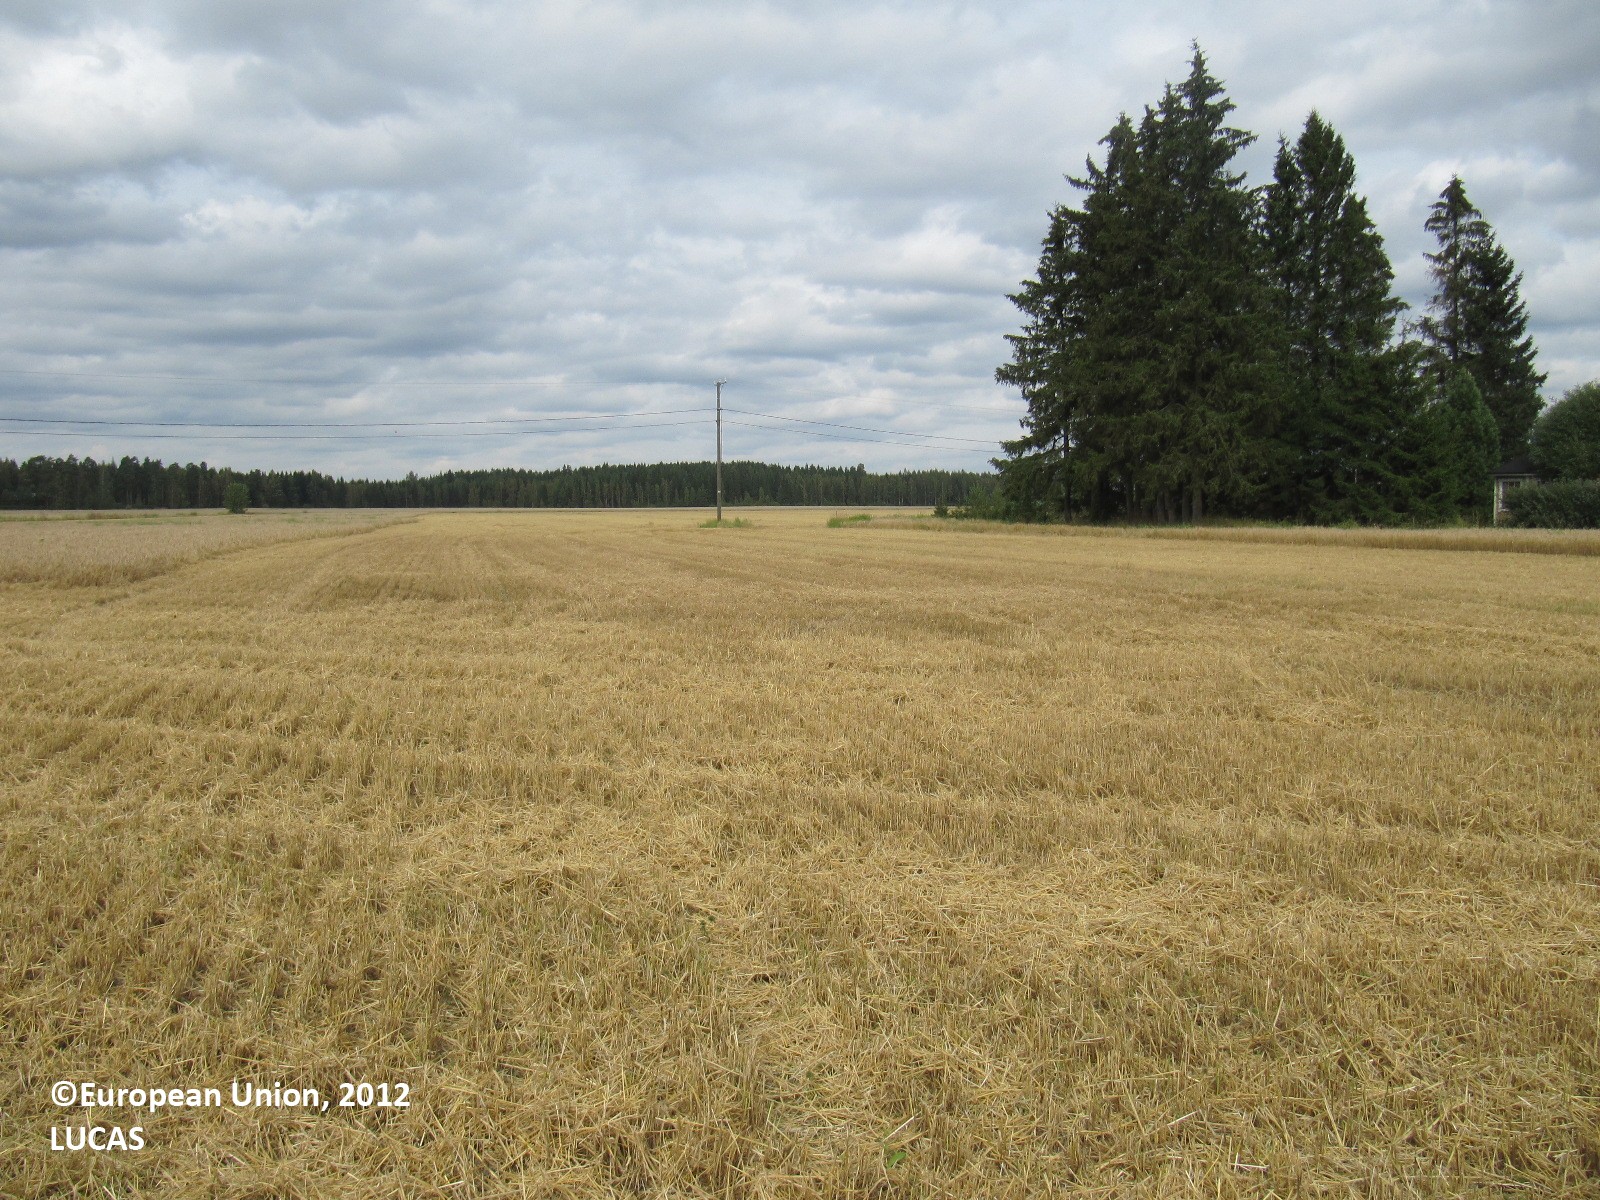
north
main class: Cropland
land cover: Barley
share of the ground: > 75 %
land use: Agriculture (excluding fallow land and kitchen gardens)
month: August
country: FI
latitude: 60.9028
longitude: 22.8855
